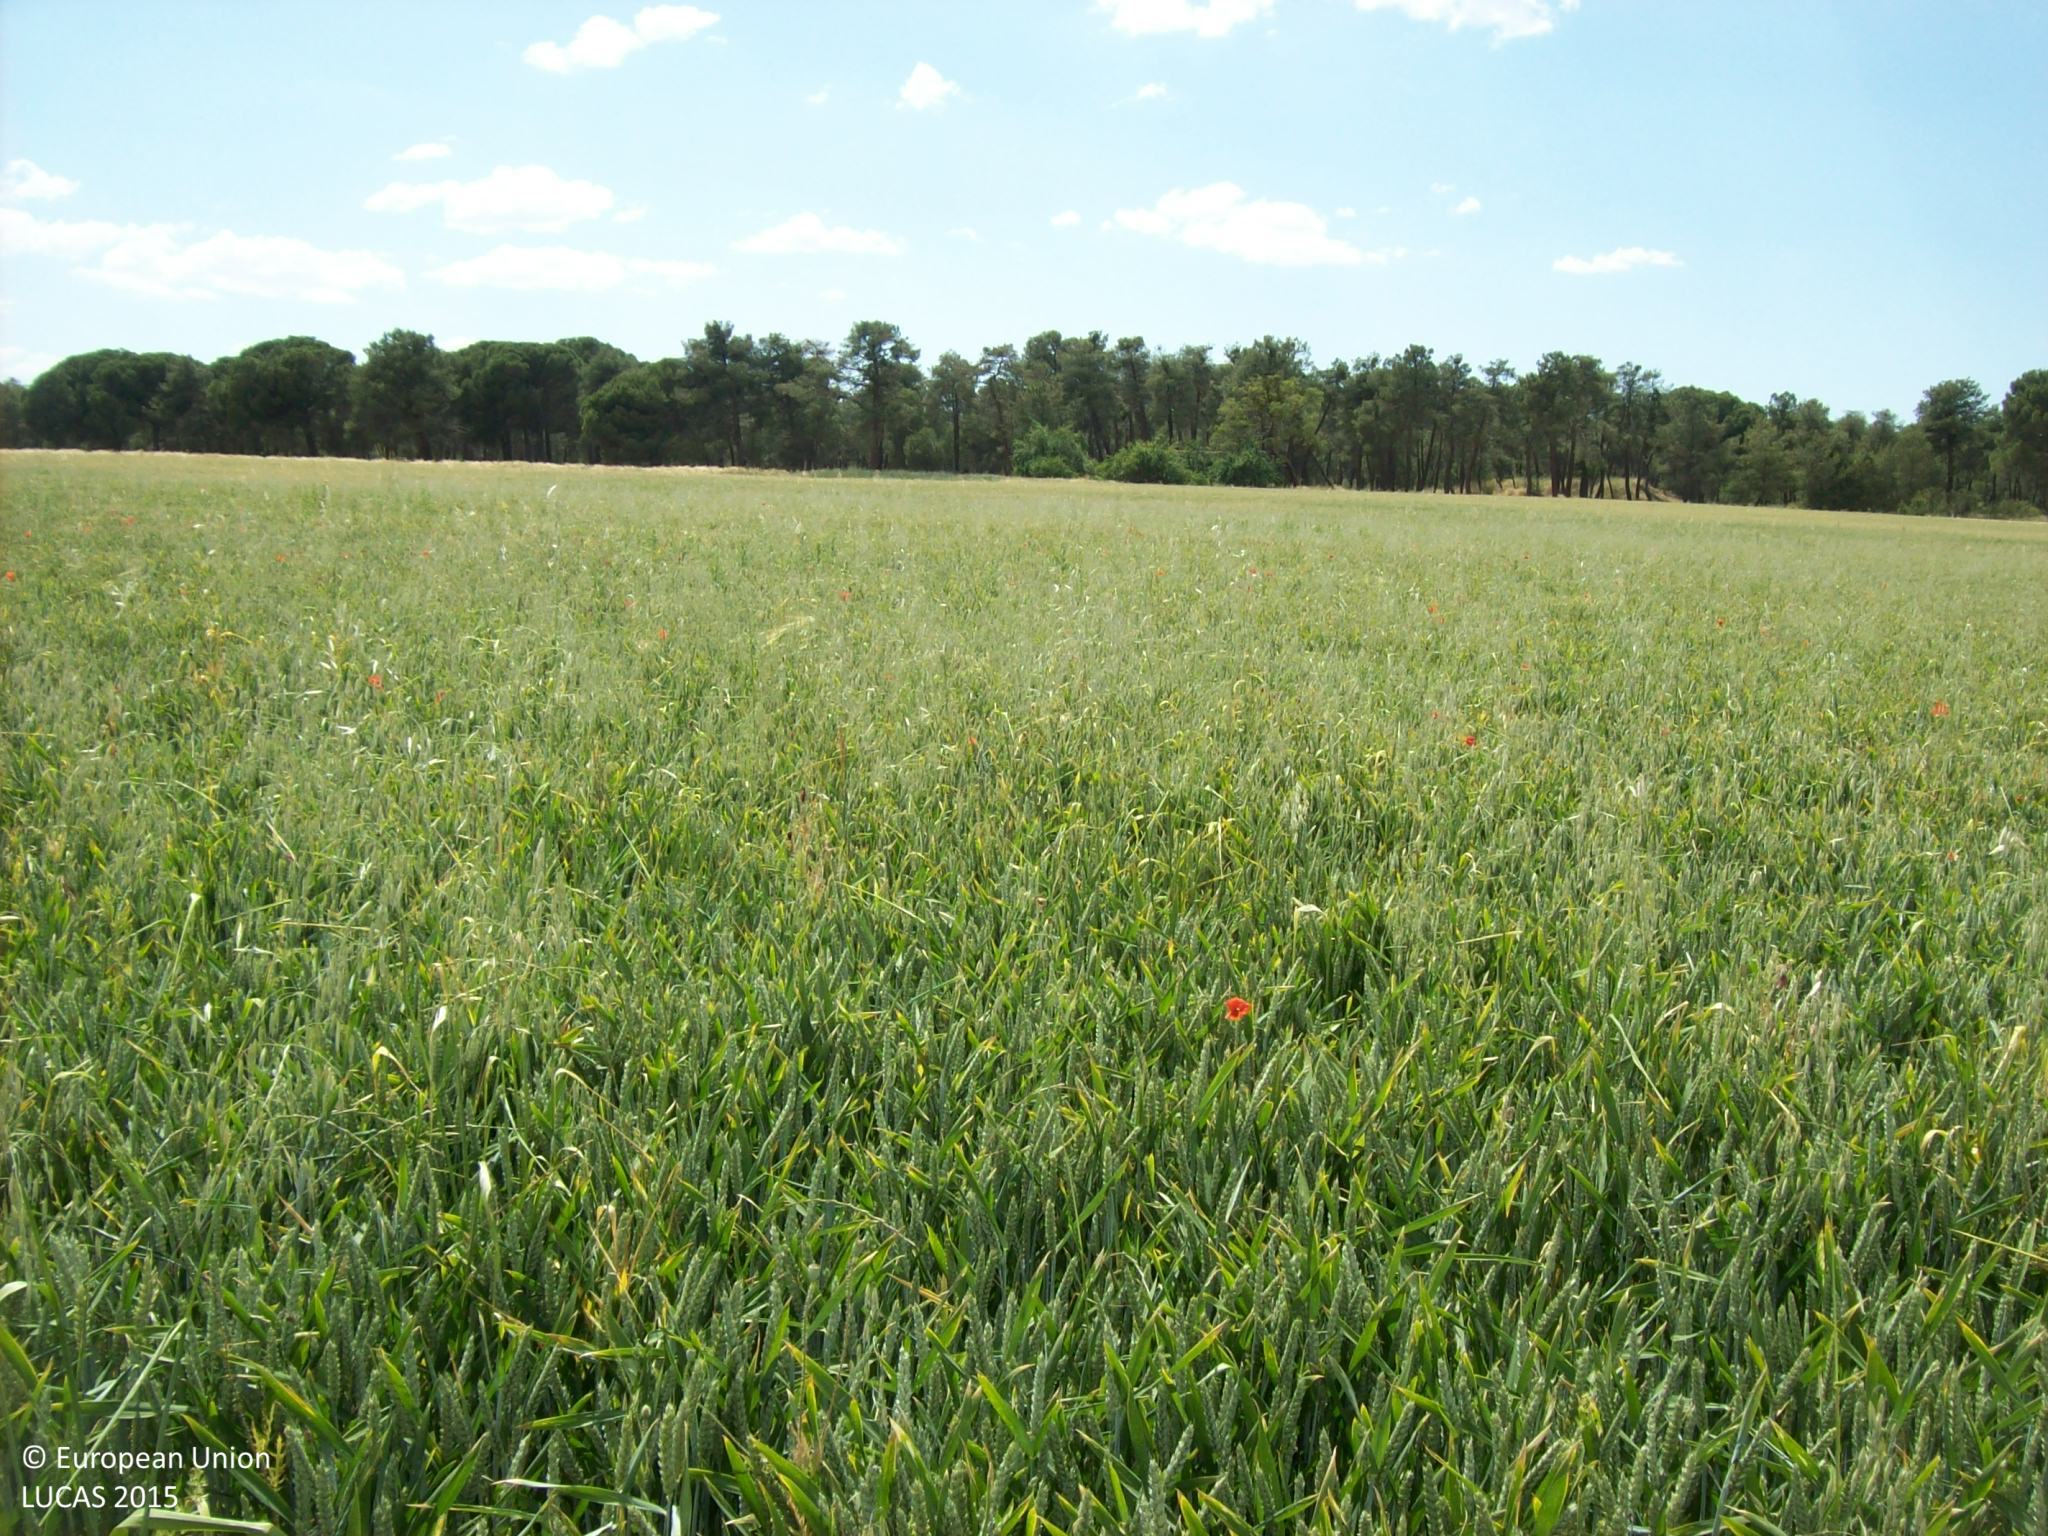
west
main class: Cropland
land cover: Common wheat
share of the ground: > 75 %
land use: Agriculture (excluding fallow land and kitchen gardens)
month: June
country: ES
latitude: 41.1376
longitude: -4.5581
